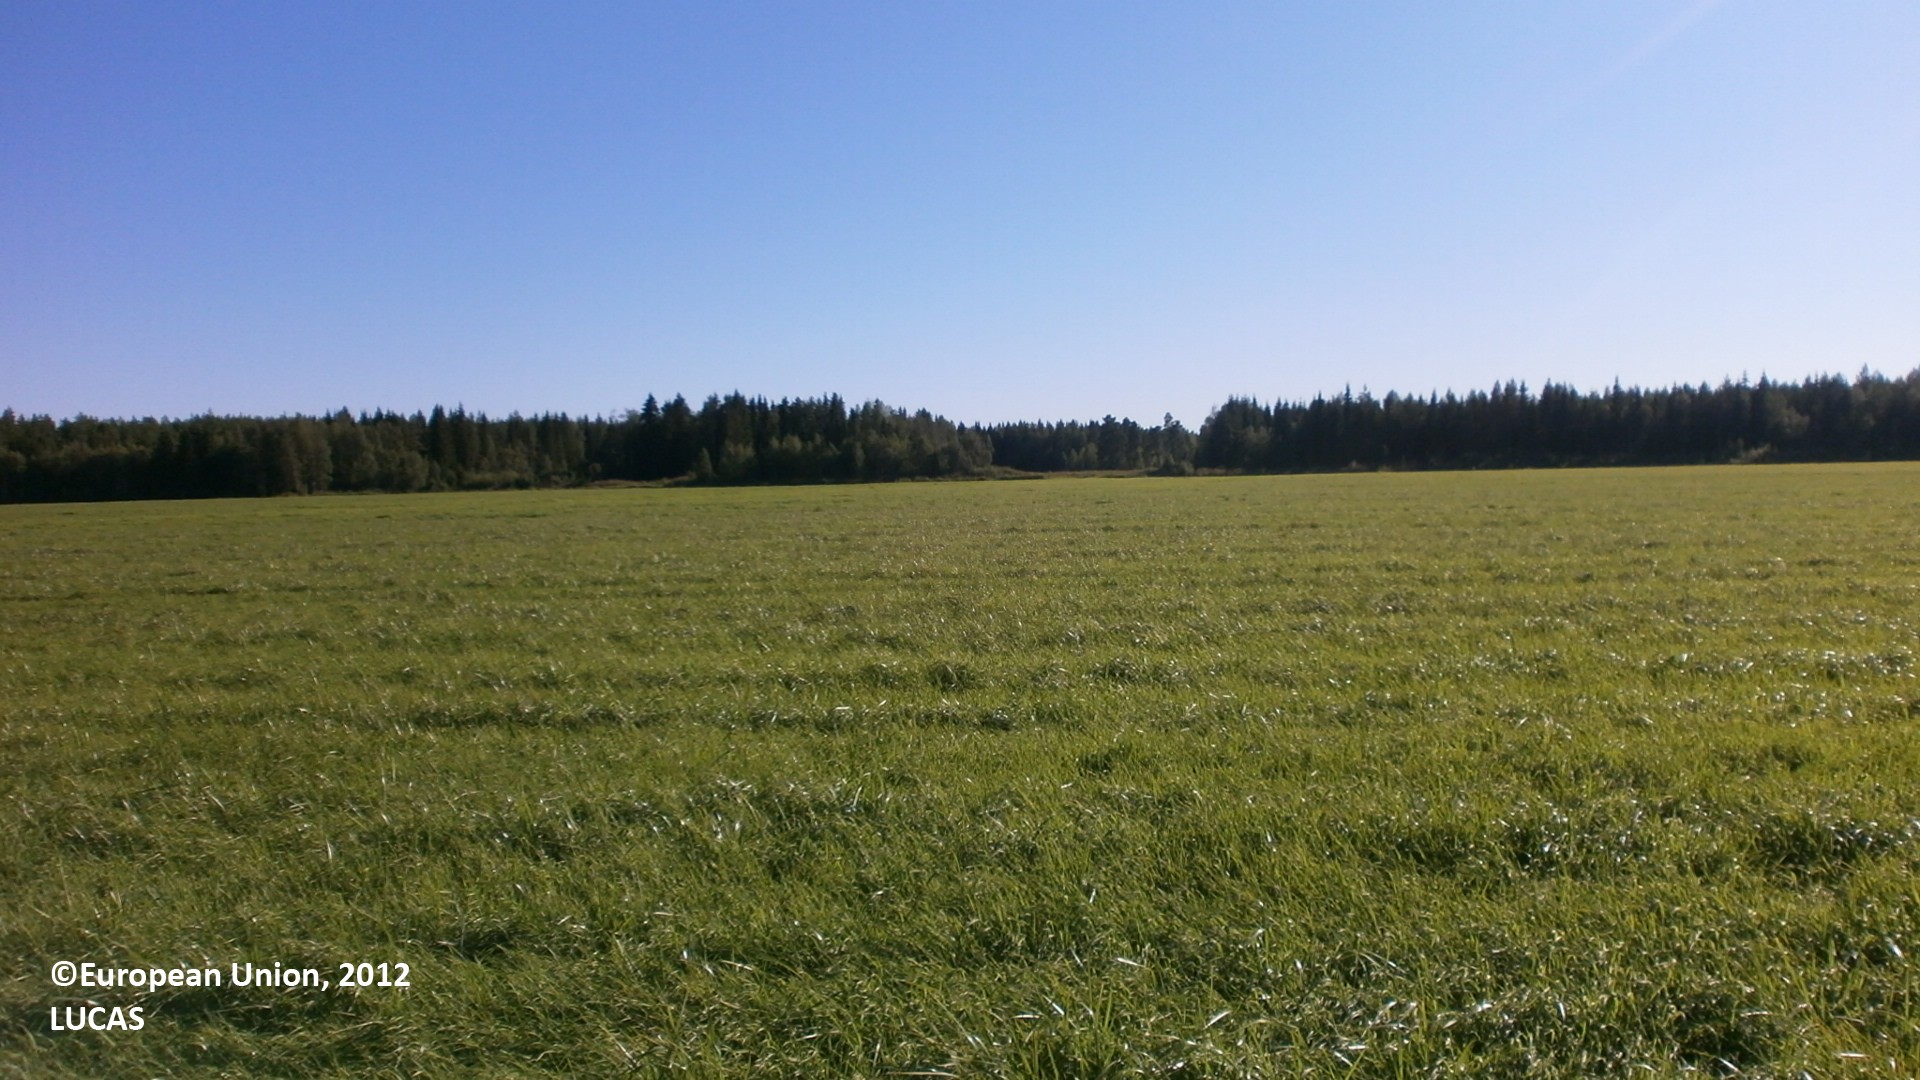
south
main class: Cropland
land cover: Temporary grasslands
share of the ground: > 75 %
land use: Agriculture (excluding fallow land and kitchen gardens)
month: July
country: FI
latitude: 64.2178
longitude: 23.9719
